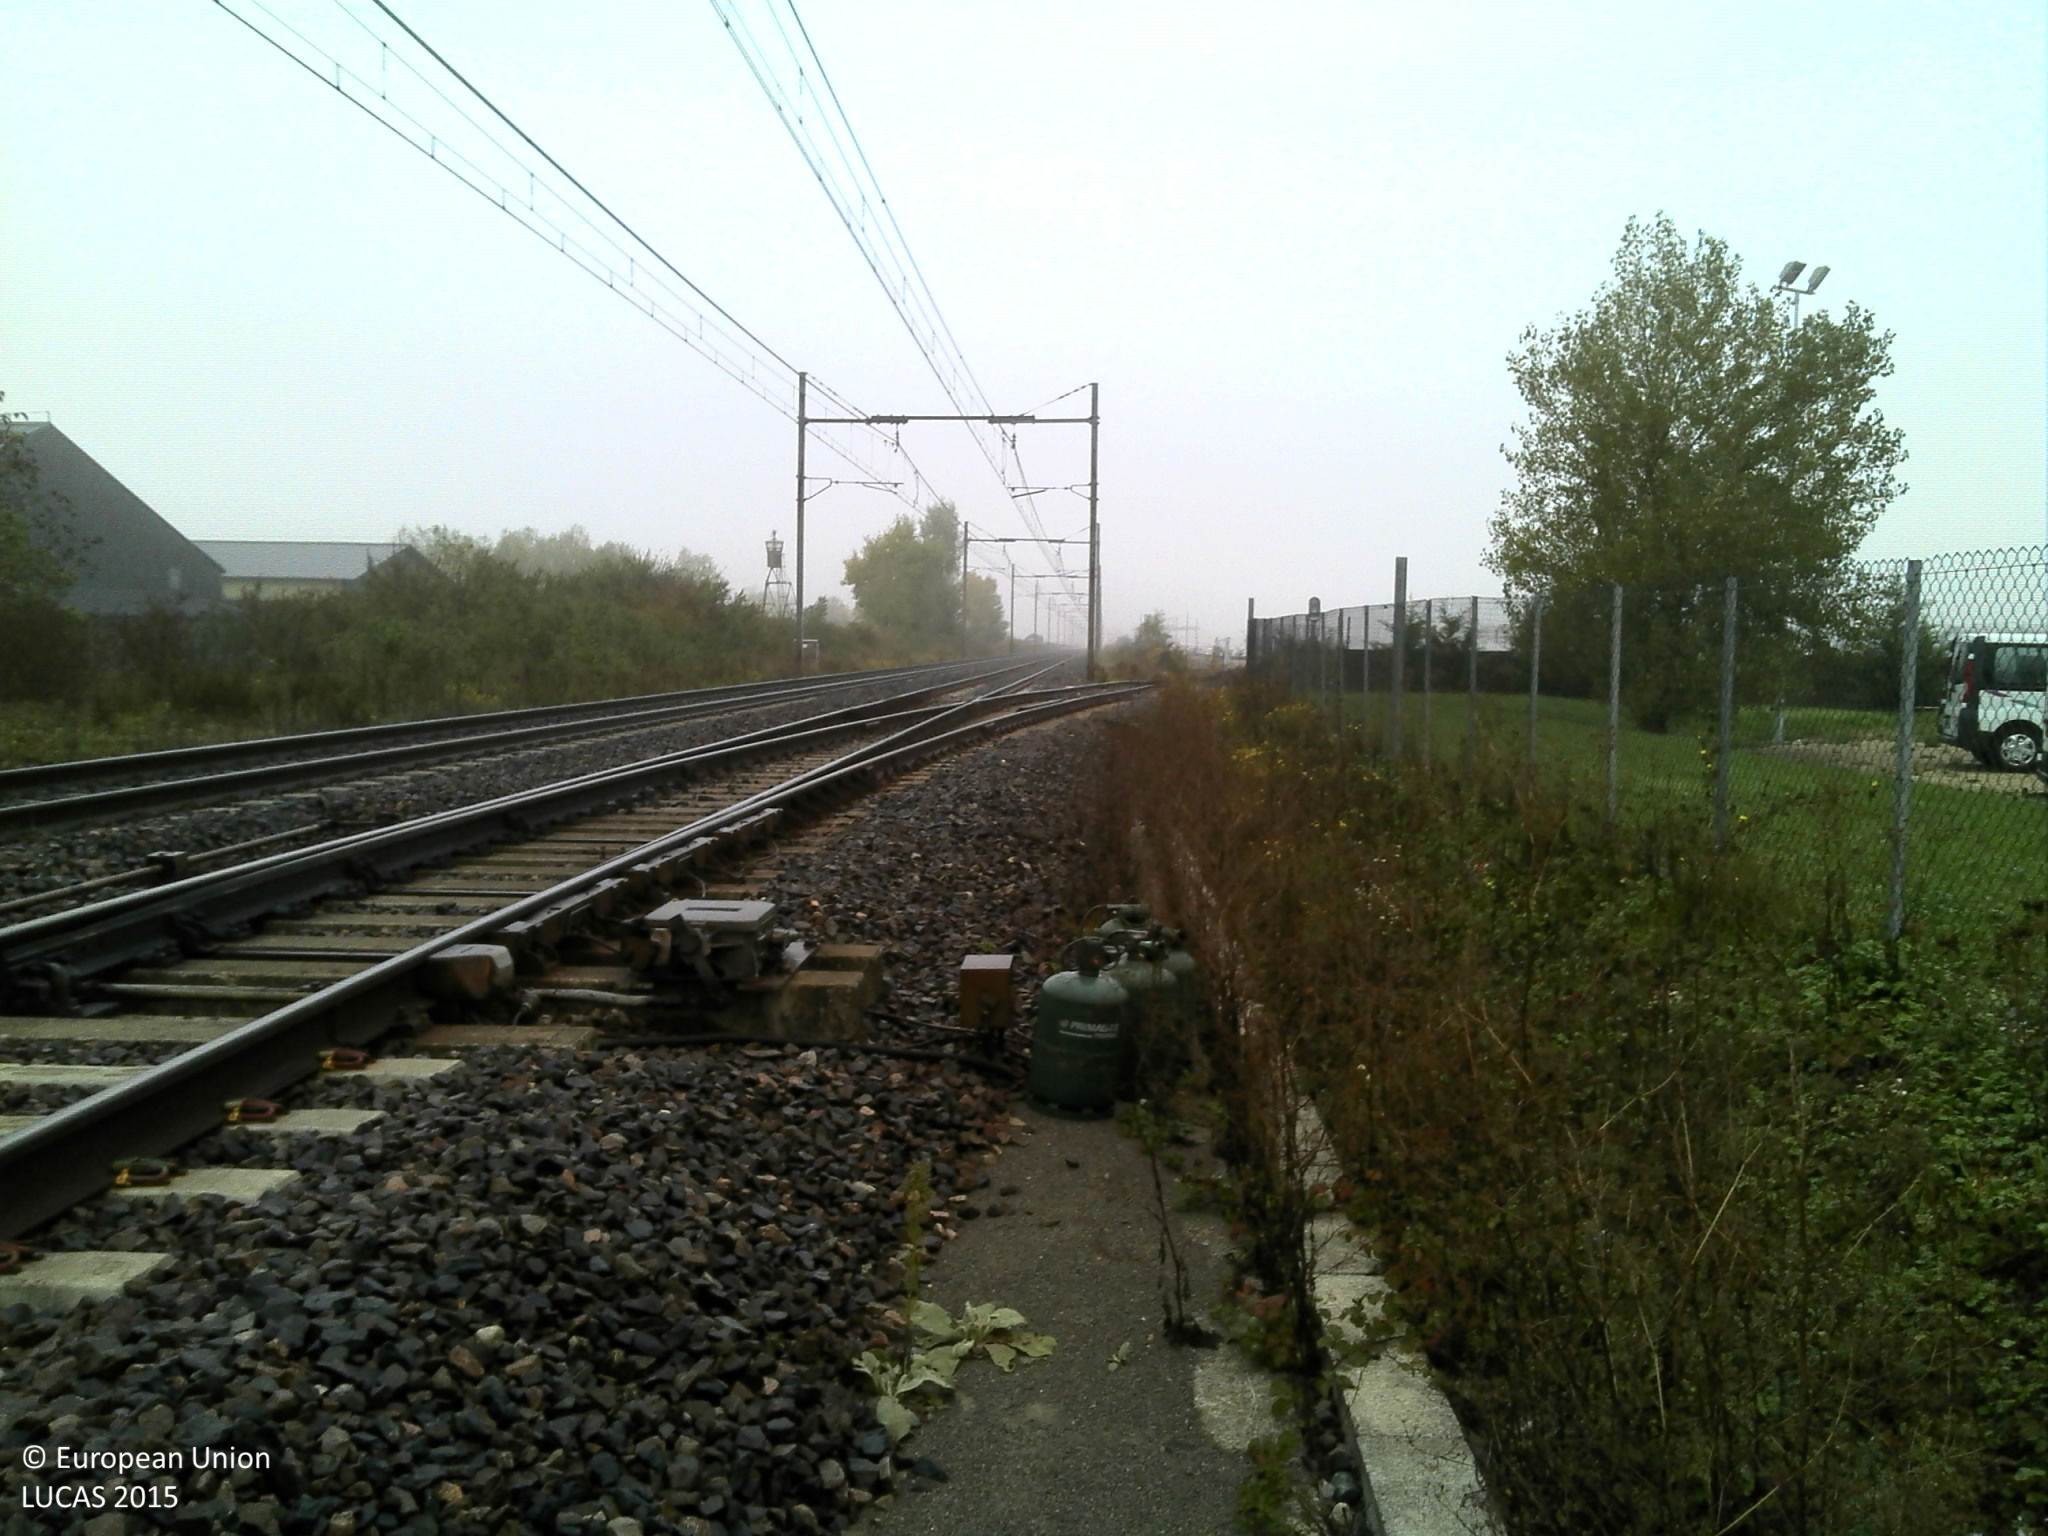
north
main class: Grassland
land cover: Grassland with sparse tree/shrub cover
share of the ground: > 75 %
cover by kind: herbaceous plants 95 %, broadleaved forest trees 5 %
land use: Air transport
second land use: Community services
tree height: > 5 m
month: October
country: FR
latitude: 45.9792
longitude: 5.3439
